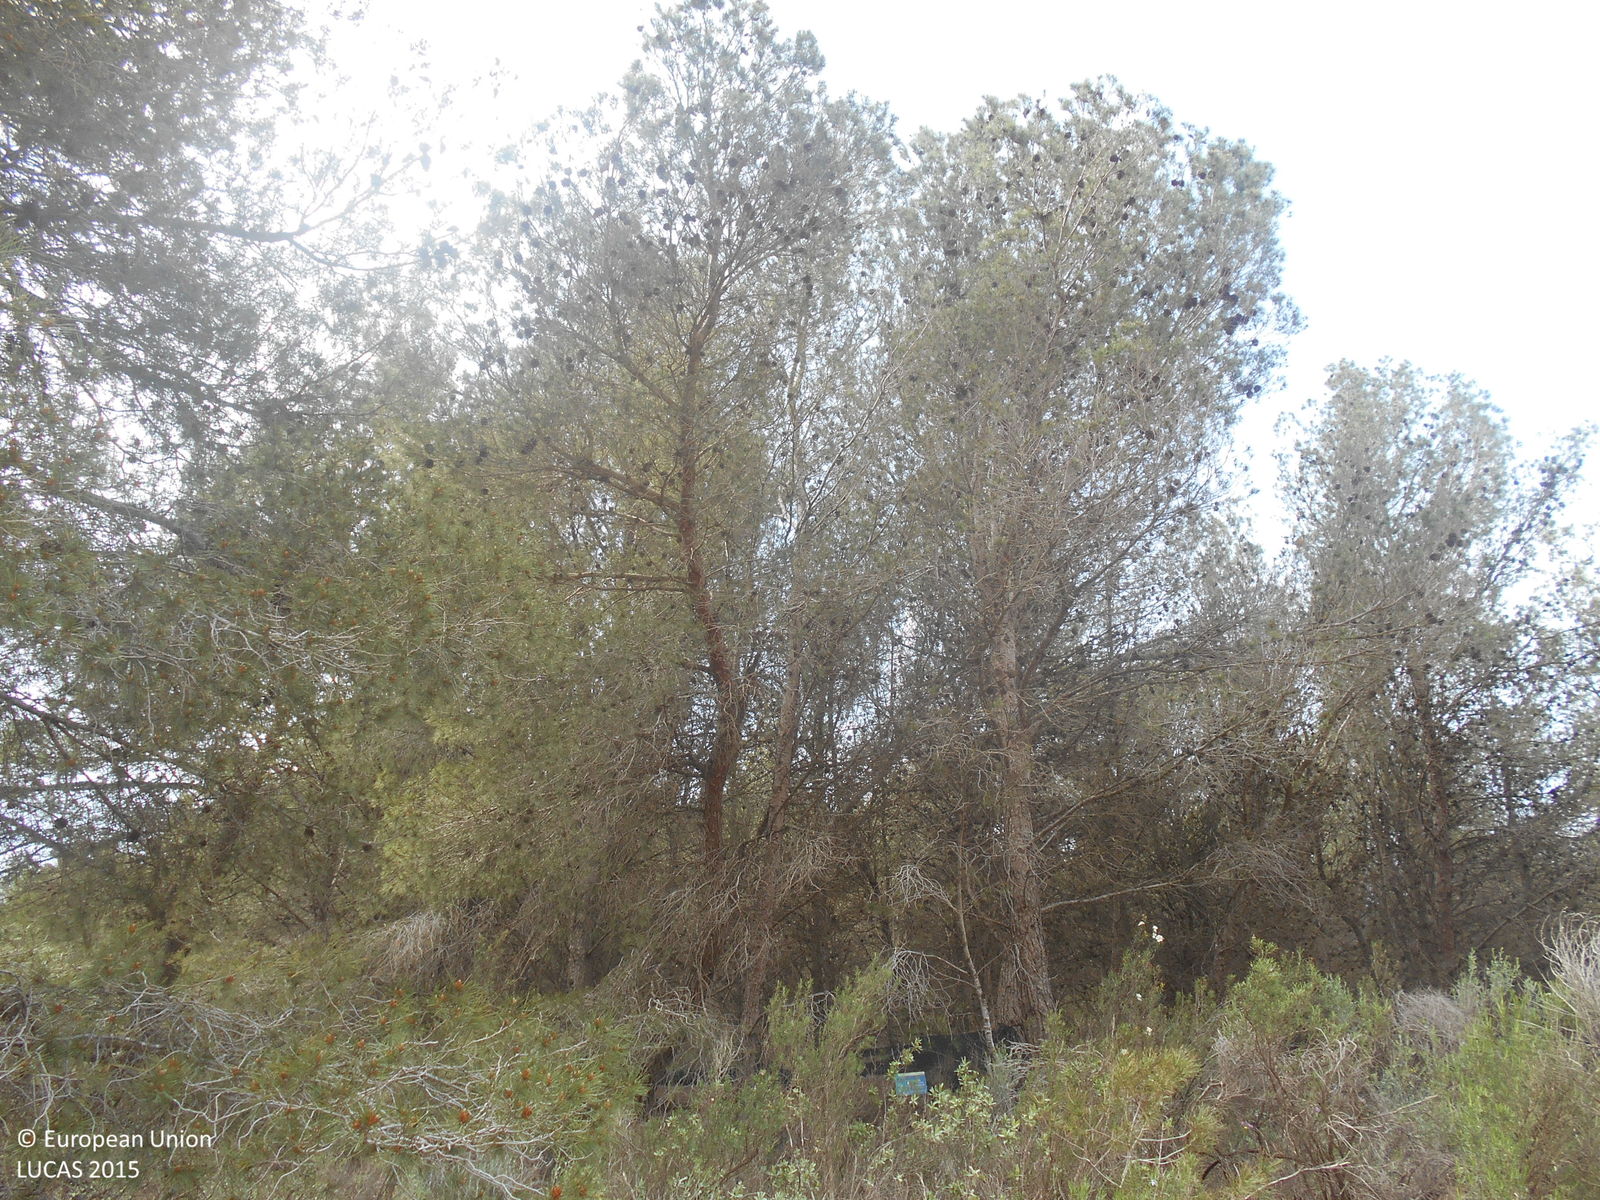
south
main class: Woodland
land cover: Pine dominated coniferous woodland
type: coniferous forest of the mediterranean region
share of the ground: > 75 %
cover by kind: coniferous forest trees 50 %, shrubs 40 %, unconsolidated bare surface 10 %
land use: Semi-natural and natural areas not in use
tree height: > 5 m
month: April
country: ES
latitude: 37.6296
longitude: -1.5276
